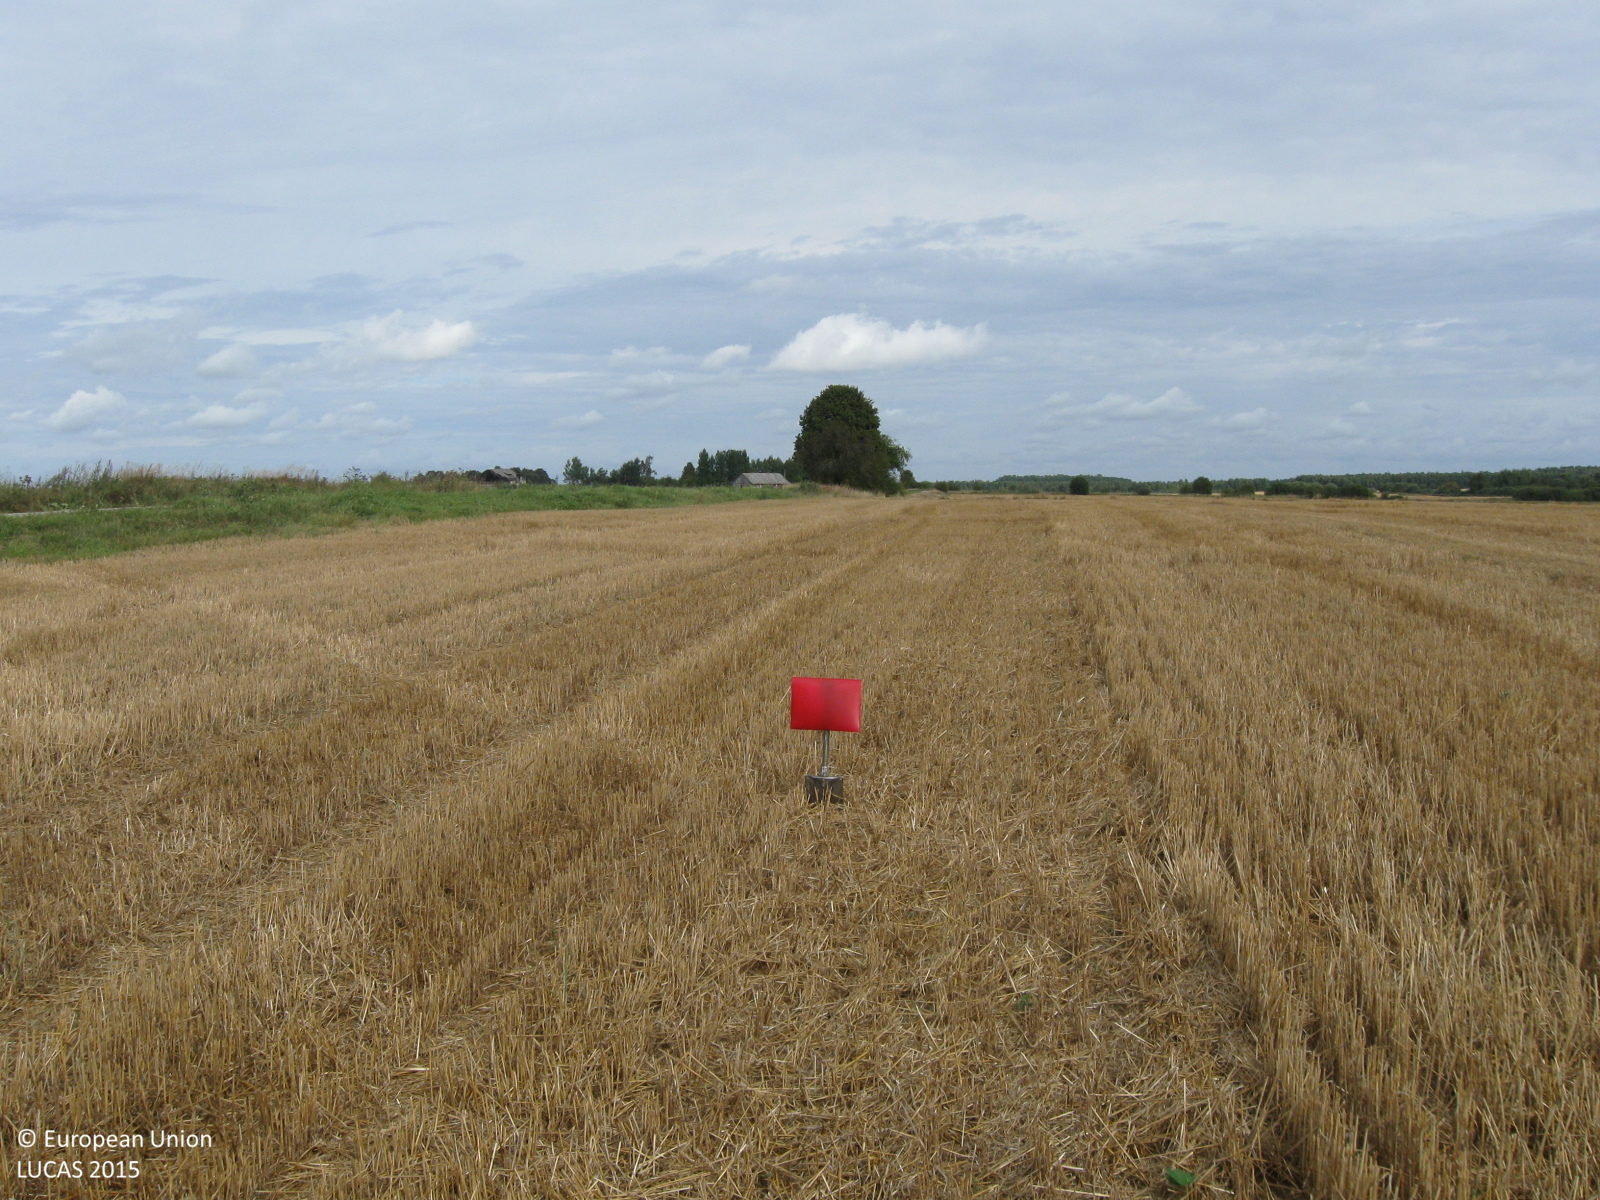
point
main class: Cropland
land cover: Common wheat
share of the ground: > 75 %
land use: Agriculture (excluding fallow land and kitchen gardens)
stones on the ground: < 10 %
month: August
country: LT
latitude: 55.6222
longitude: 23.2705
